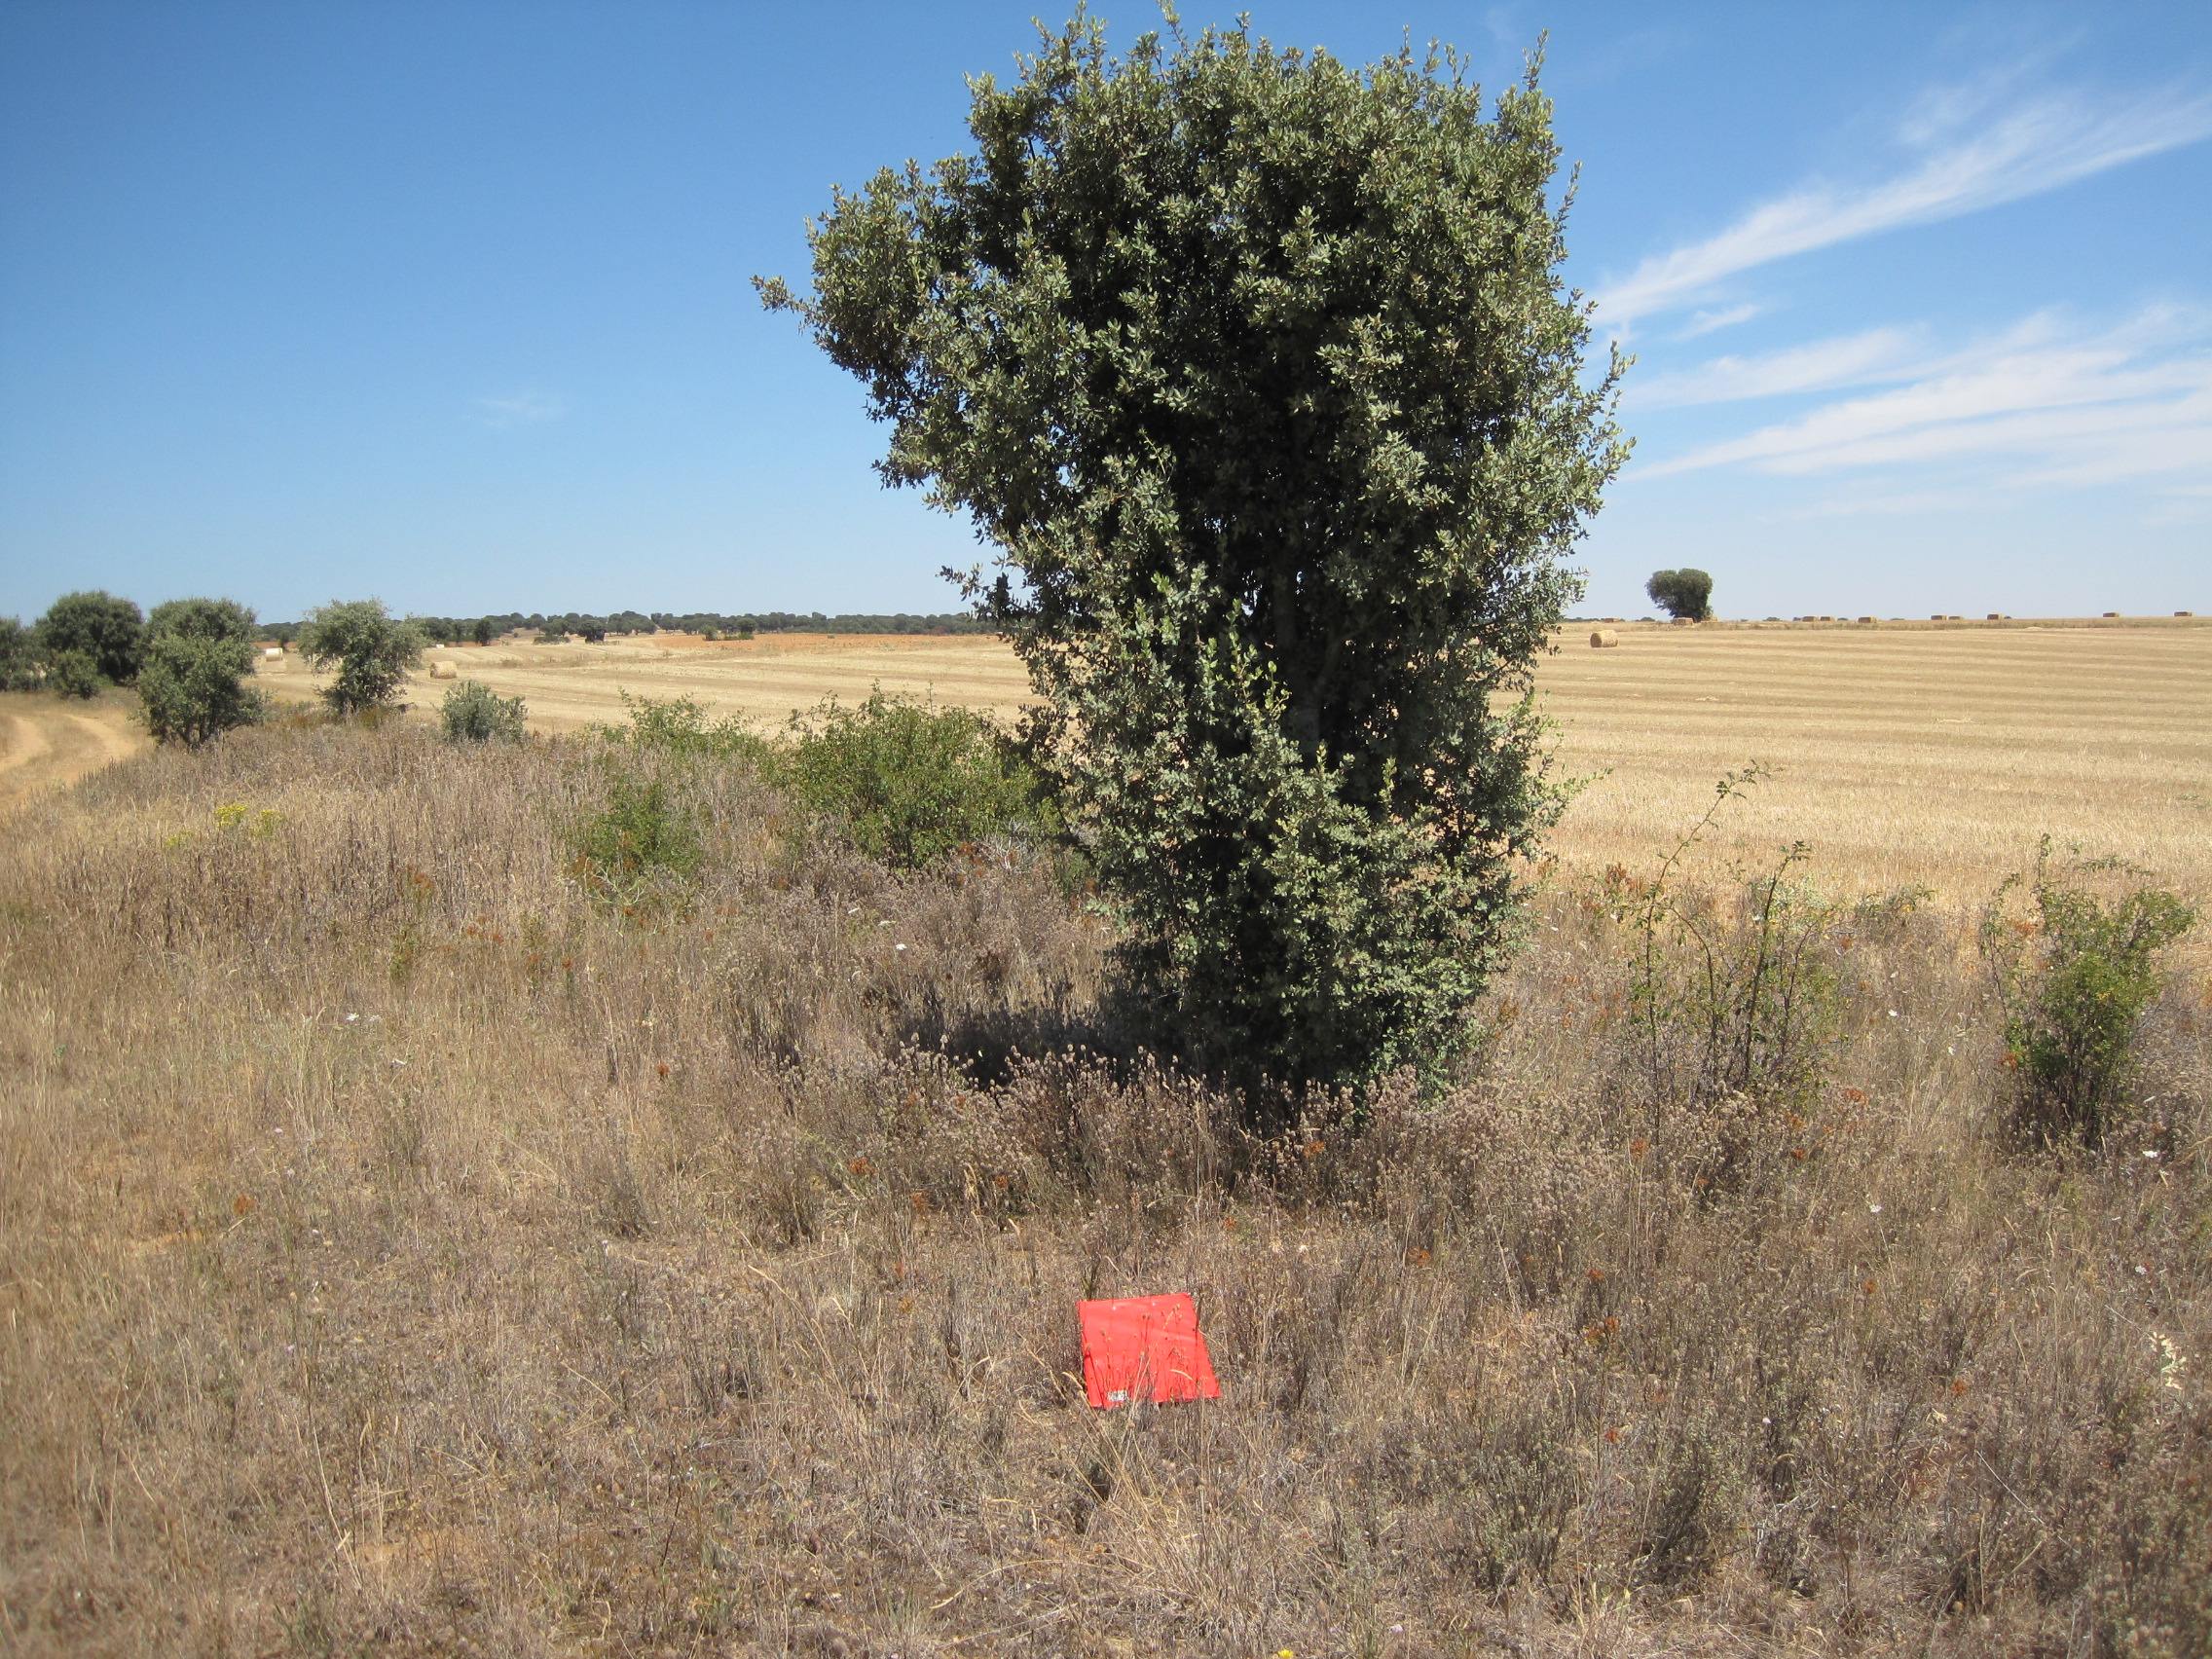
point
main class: Shrubland
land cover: Shrubland with sparse tree cover
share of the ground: 25 - 50 %
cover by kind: shrubs 50 %, herbaceous plants 35 %, unconsolidated bare surface 10 %, broadleaved forest trees 5 %
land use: Abandoned areas
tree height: < 5 m
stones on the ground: < 10 %
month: July
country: ES
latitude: 42.1210
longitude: -5.6849
